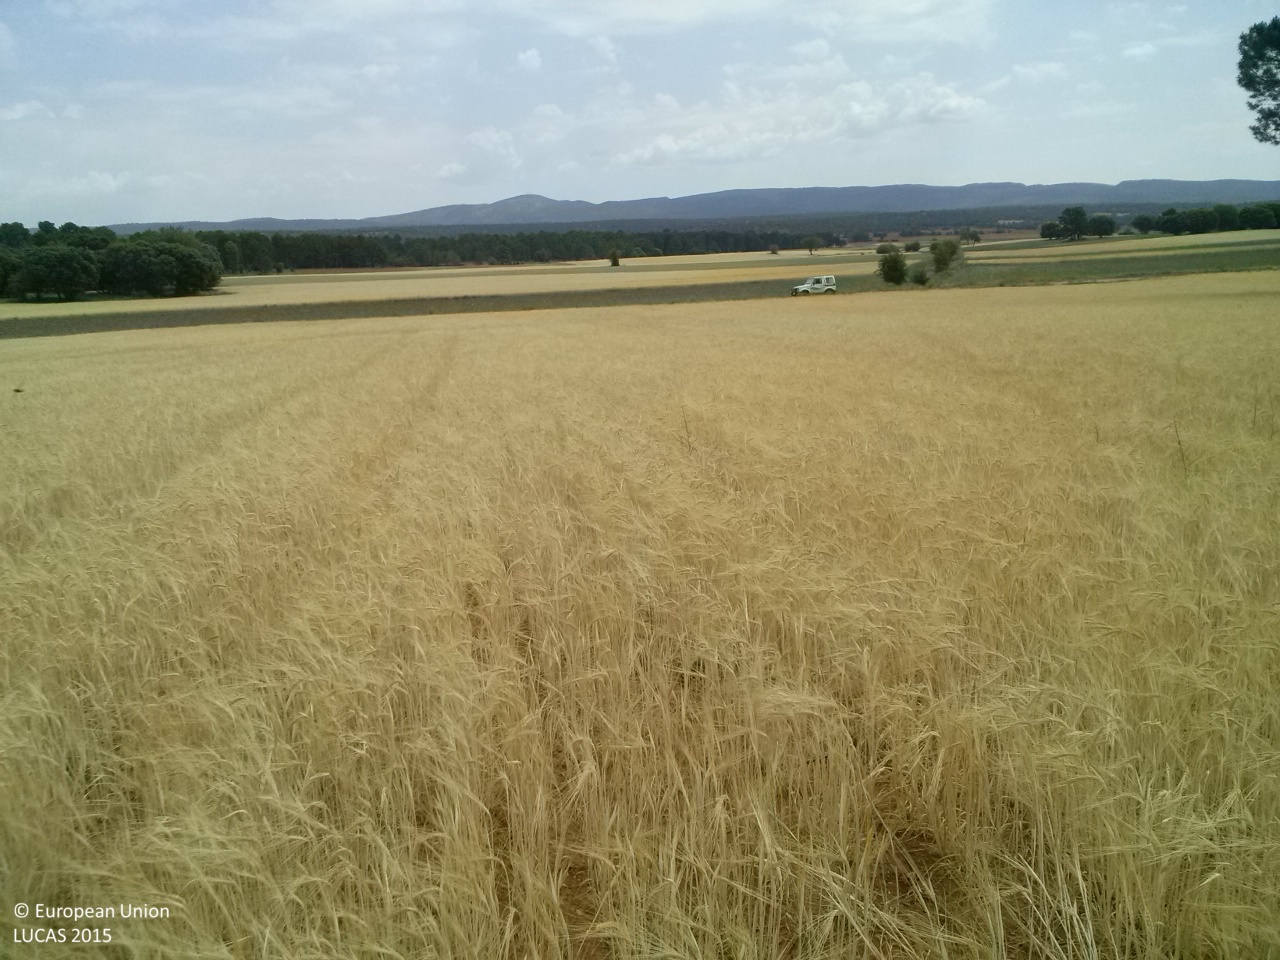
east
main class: Cropland
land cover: Barley
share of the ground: > 75 %
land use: Agriculture (excluding fallow land and kitchen gardens)
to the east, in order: Barley; Grass margins; Tracks; Grass margins; Other fibre and oleaginous crops; Barley
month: June
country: ES
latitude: 39.9724
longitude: -1.8023
